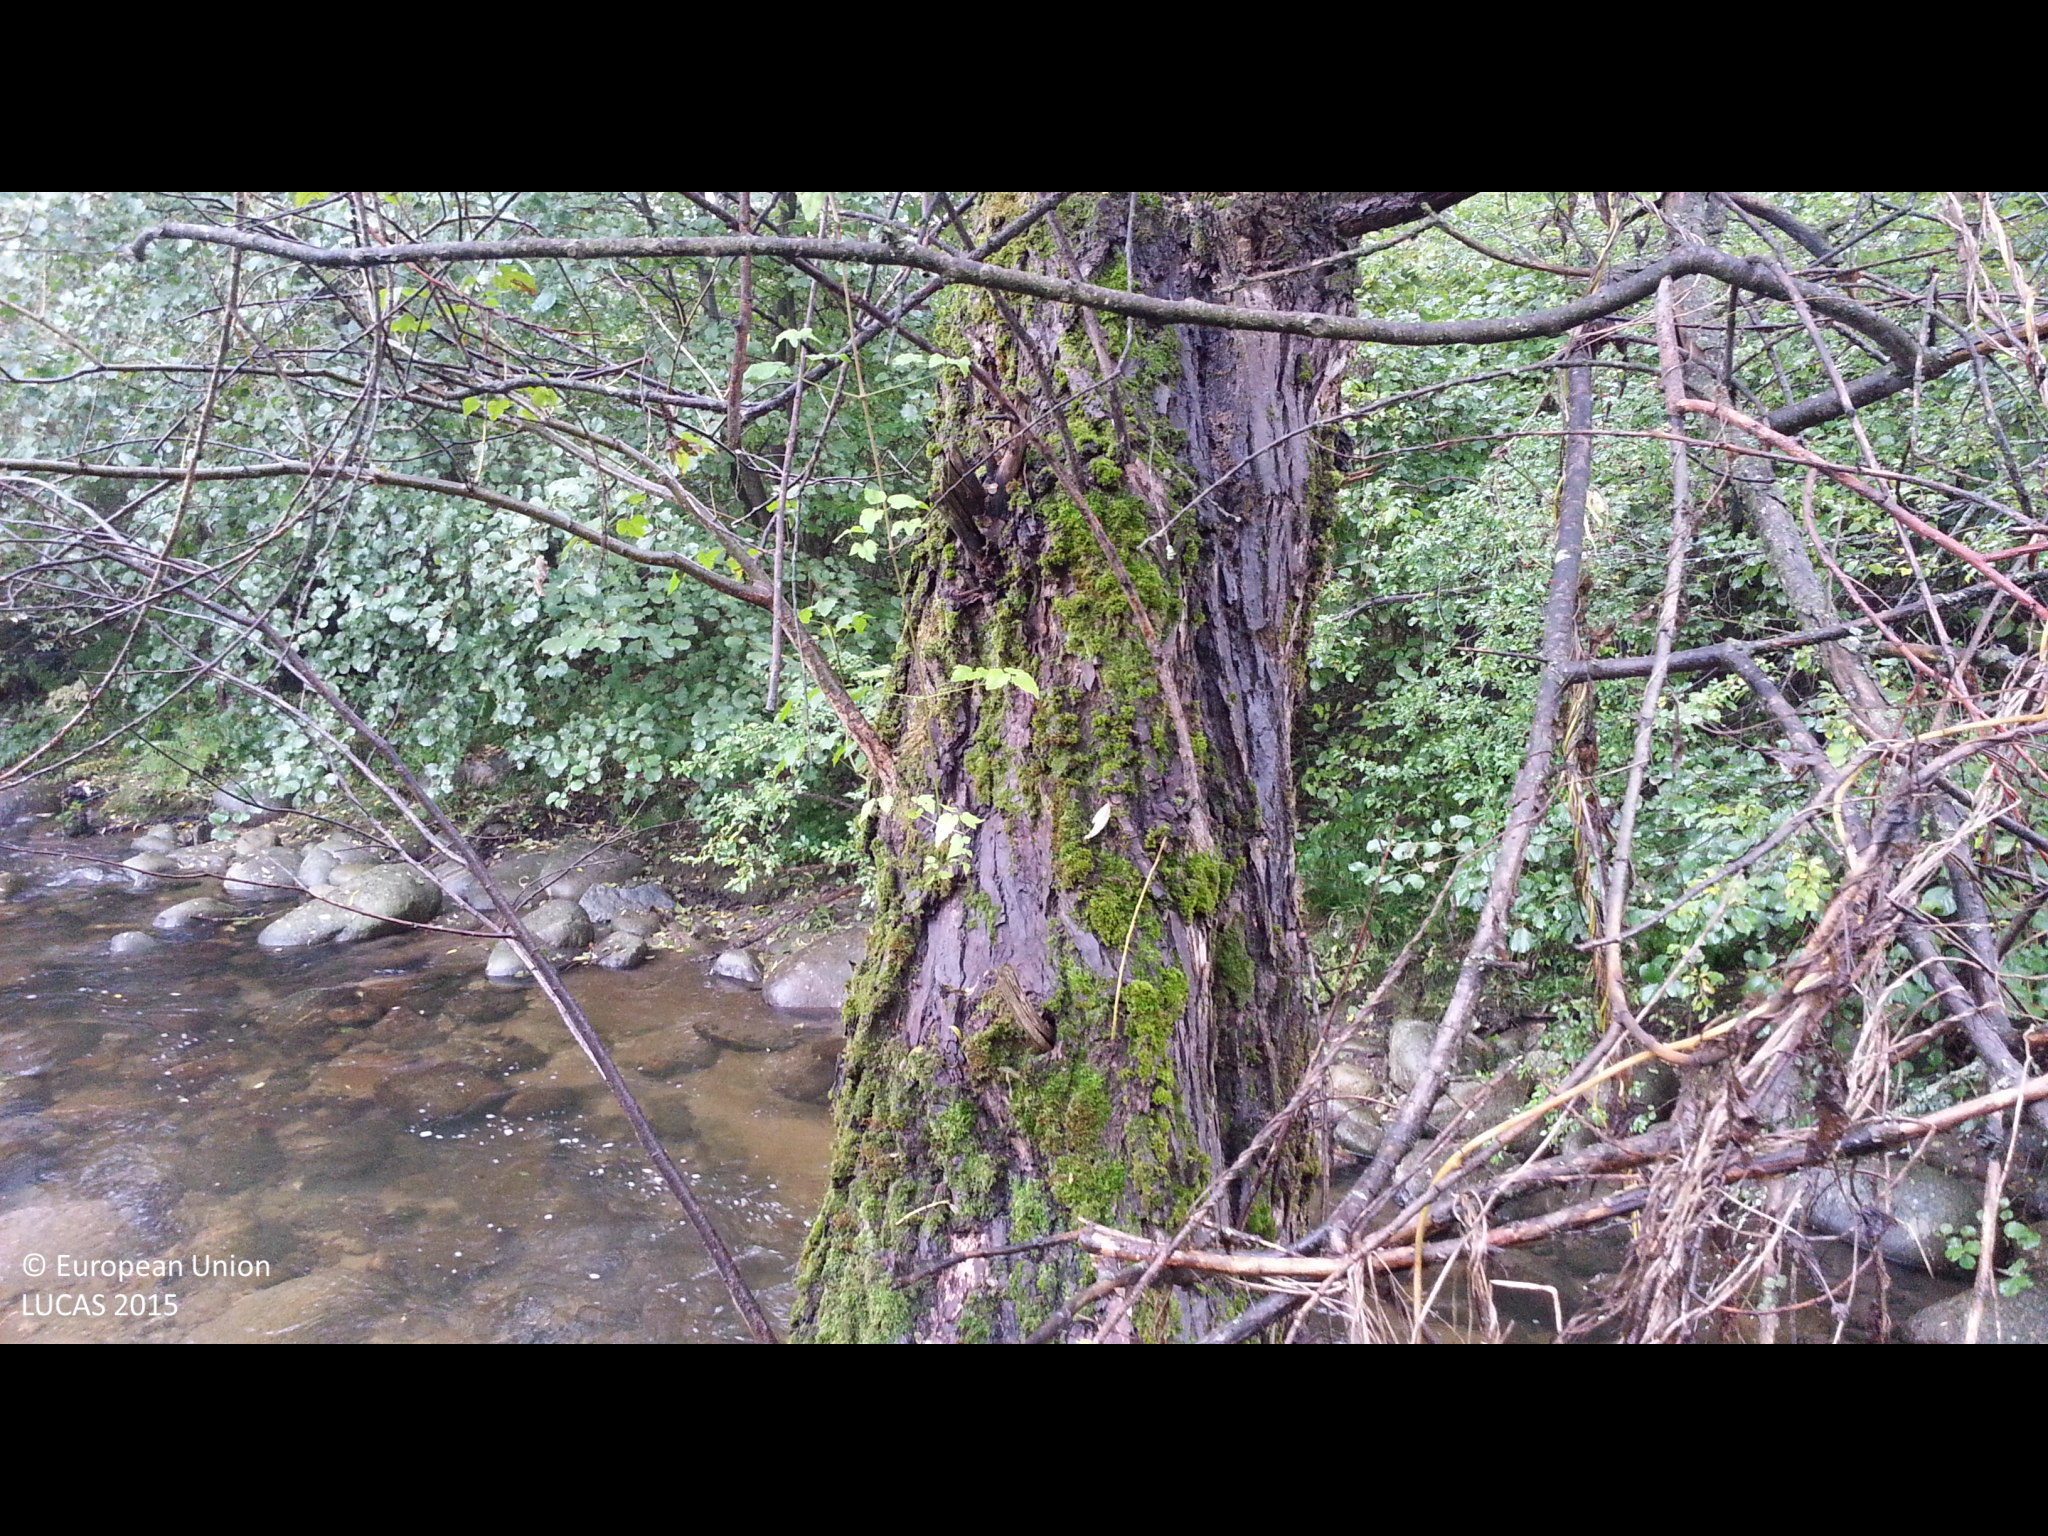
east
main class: Shrubland
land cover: Shrubland with sparse tree cover
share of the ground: > 75 %
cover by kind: shrubs 80 %, herbaceous plants 15 %, broadleaved forest trees 5 %
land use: Semi-natural and natural areas not in use
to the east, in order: Shrubland with sparse tree cover; Rivers and streams; Broadleaved woodland; Grassland with sparse tree/shrub cover; Broadleaved woodland; Grassland with sparse tree/shrub cover; Broadleaved woodland; Grass margins; Tracks; Grass margins; Arable land (only in case pi)
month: October
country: BG
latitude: 42.3025
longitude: 23.7069
